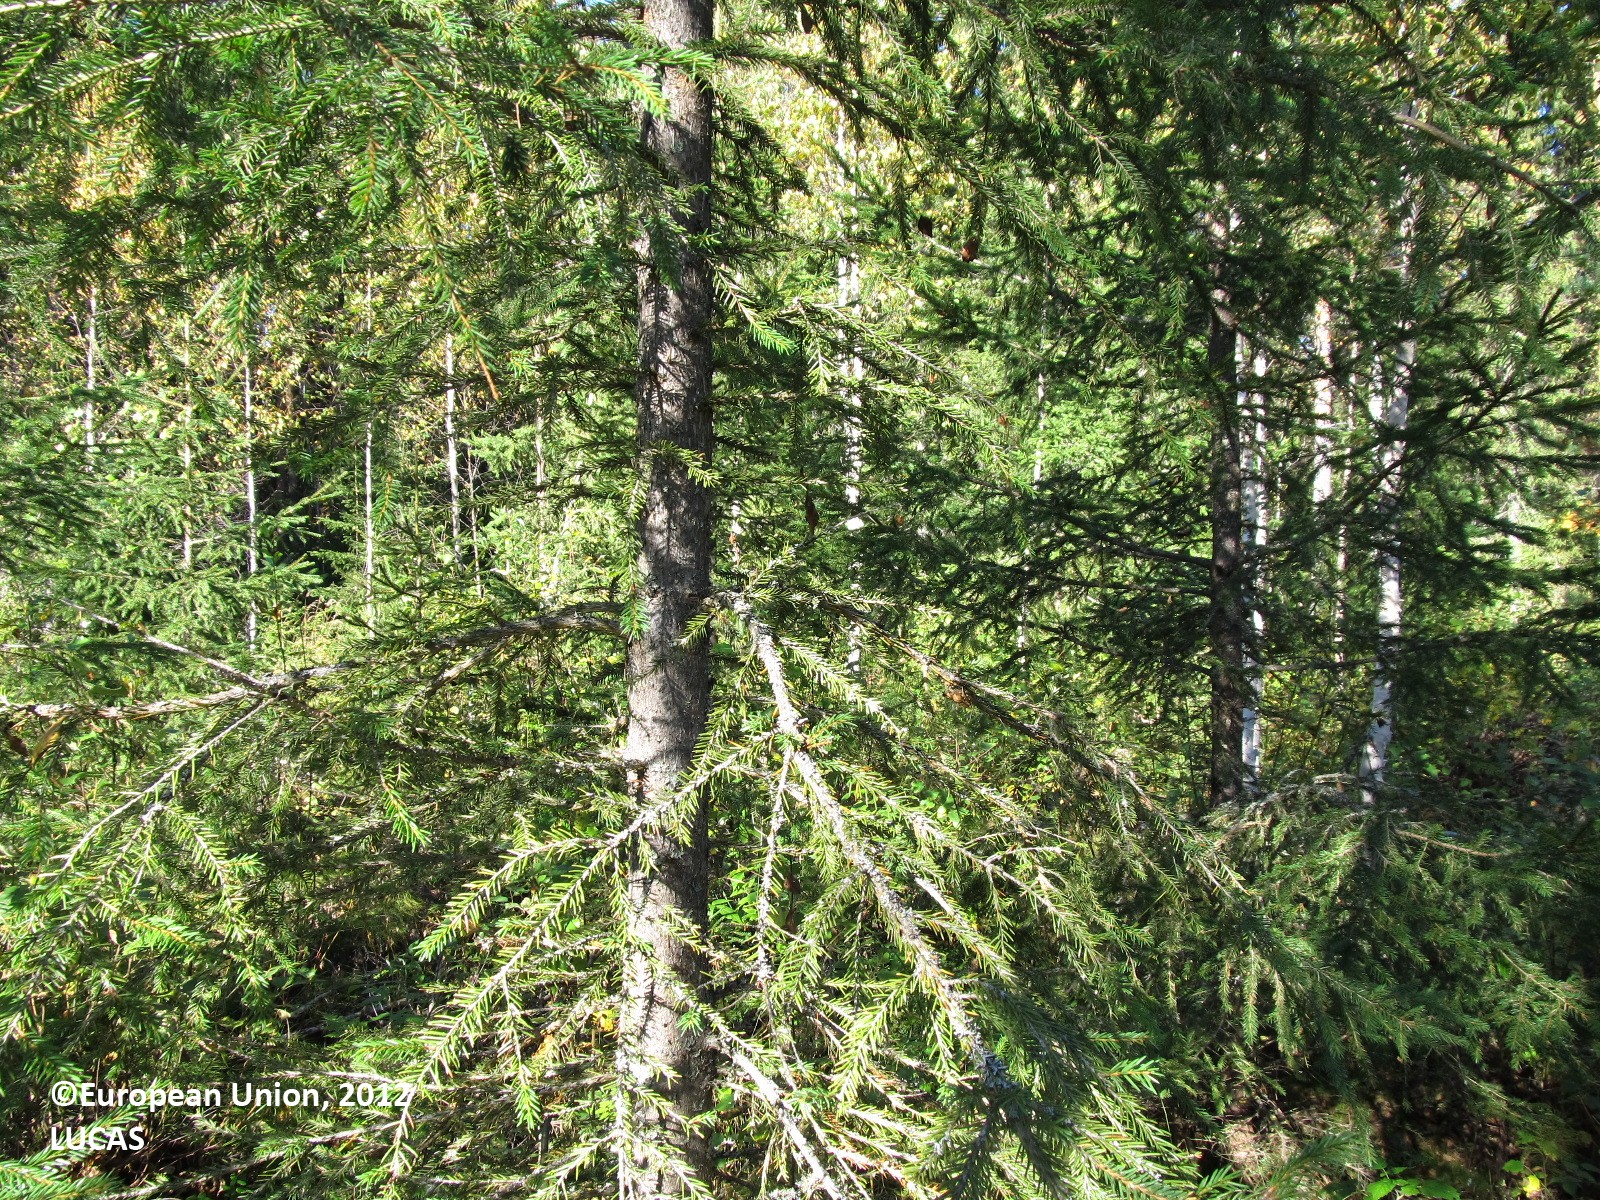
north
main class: Woodland
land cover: Spruce dominated mixed woodland
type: boreal forest
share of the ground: 50 - 75 %
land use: Forestry
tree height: > 5 m
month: September
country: FI
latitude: 62.4412
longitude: 28.3102
